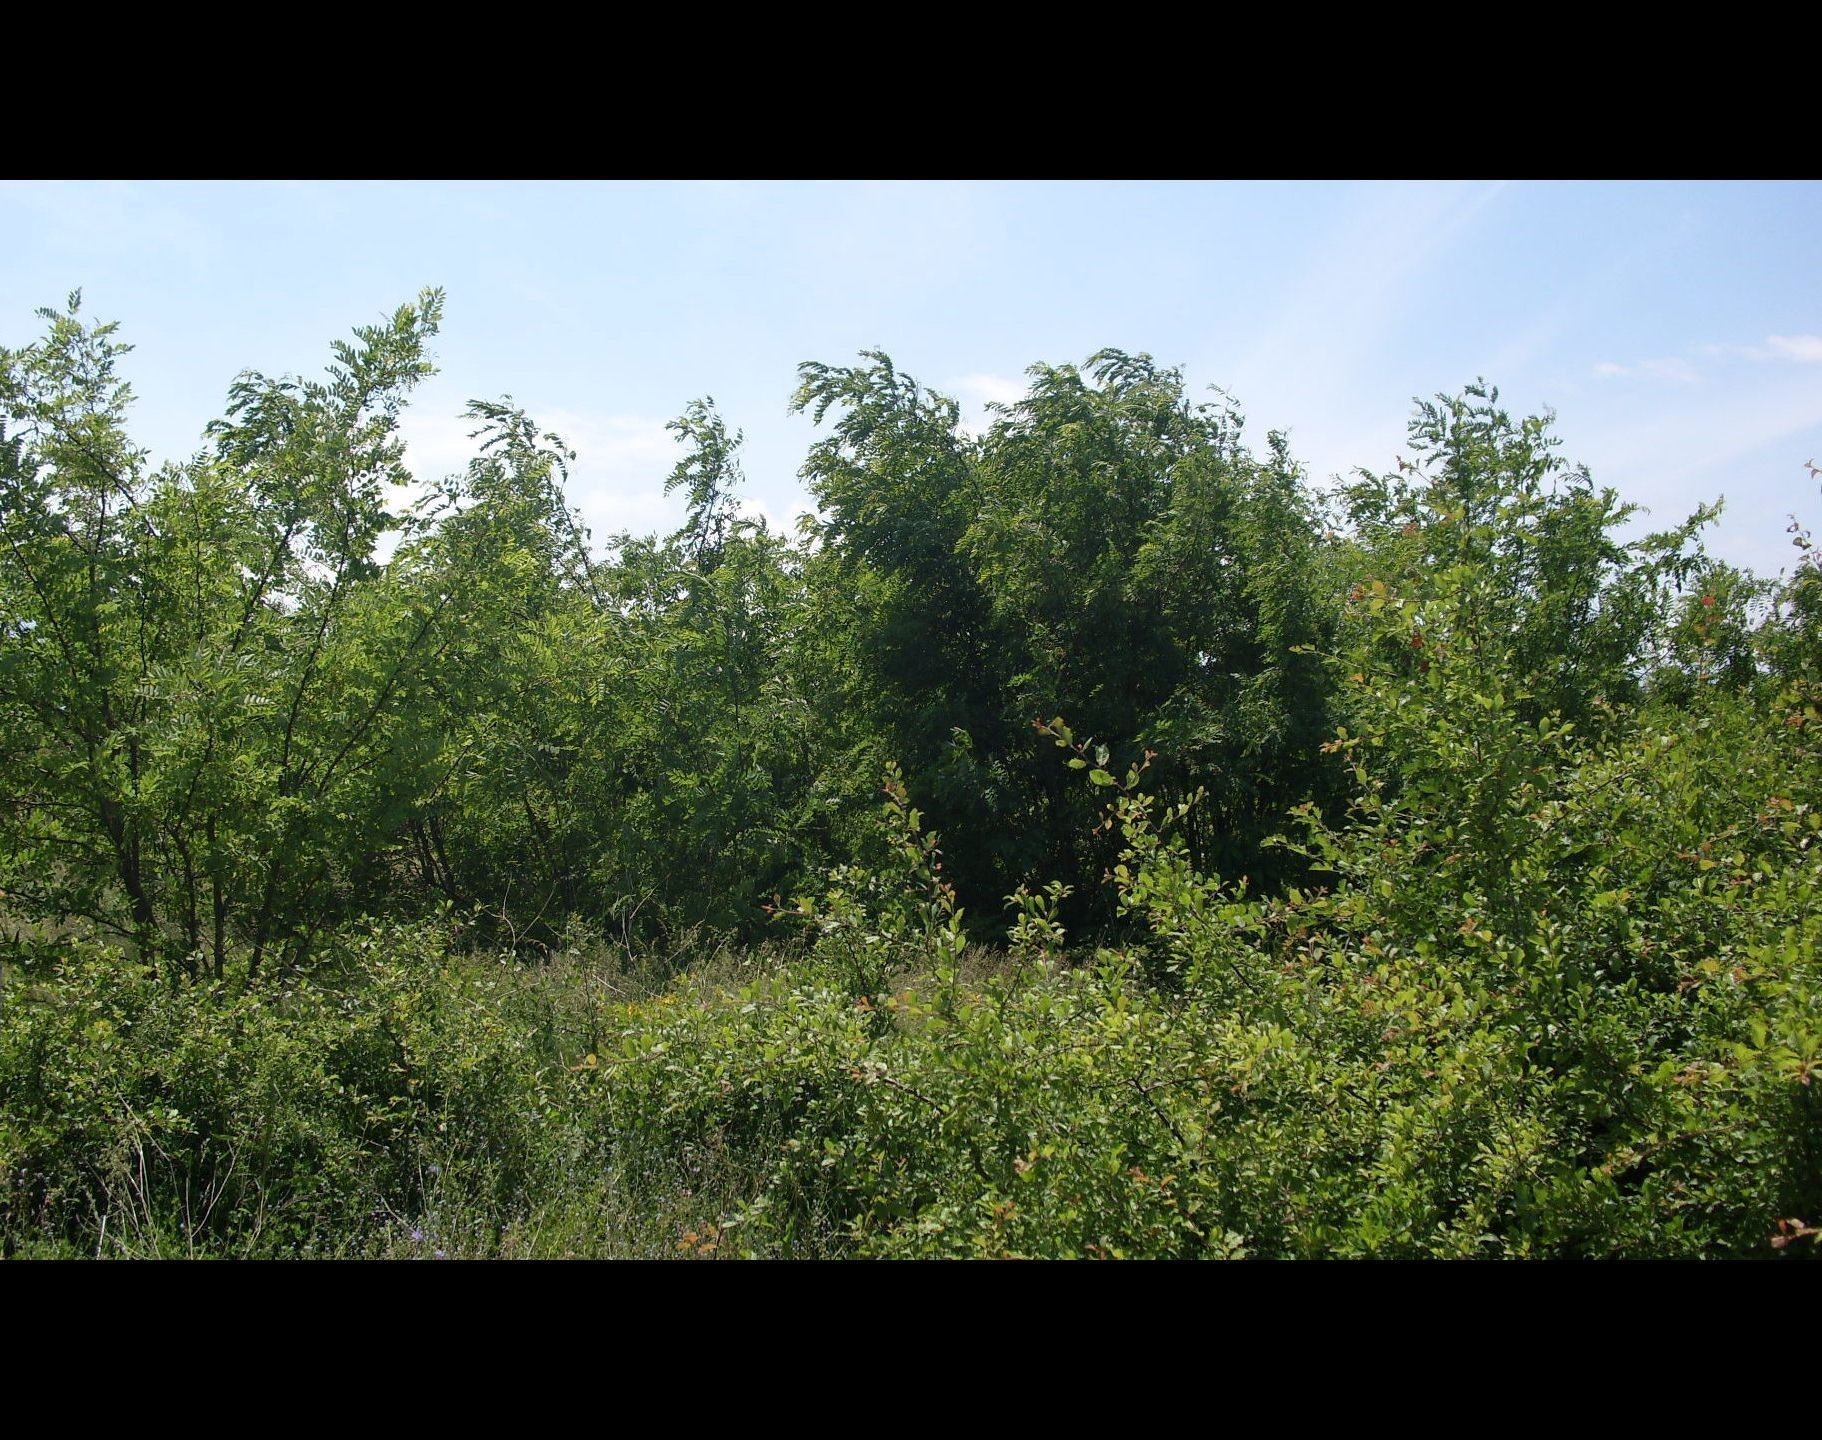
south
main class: Grassland
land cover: Grassland with sparse tree/shrub cover
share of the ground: > 75 %
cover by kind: herbaceous plants 90 %, broadleaved forest trees 5 %, shrubs 5 %
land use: Semi-natural and natural areas not in use
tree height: < 5 m
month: May
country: BG
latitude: 43.3697
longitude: 23.3822
